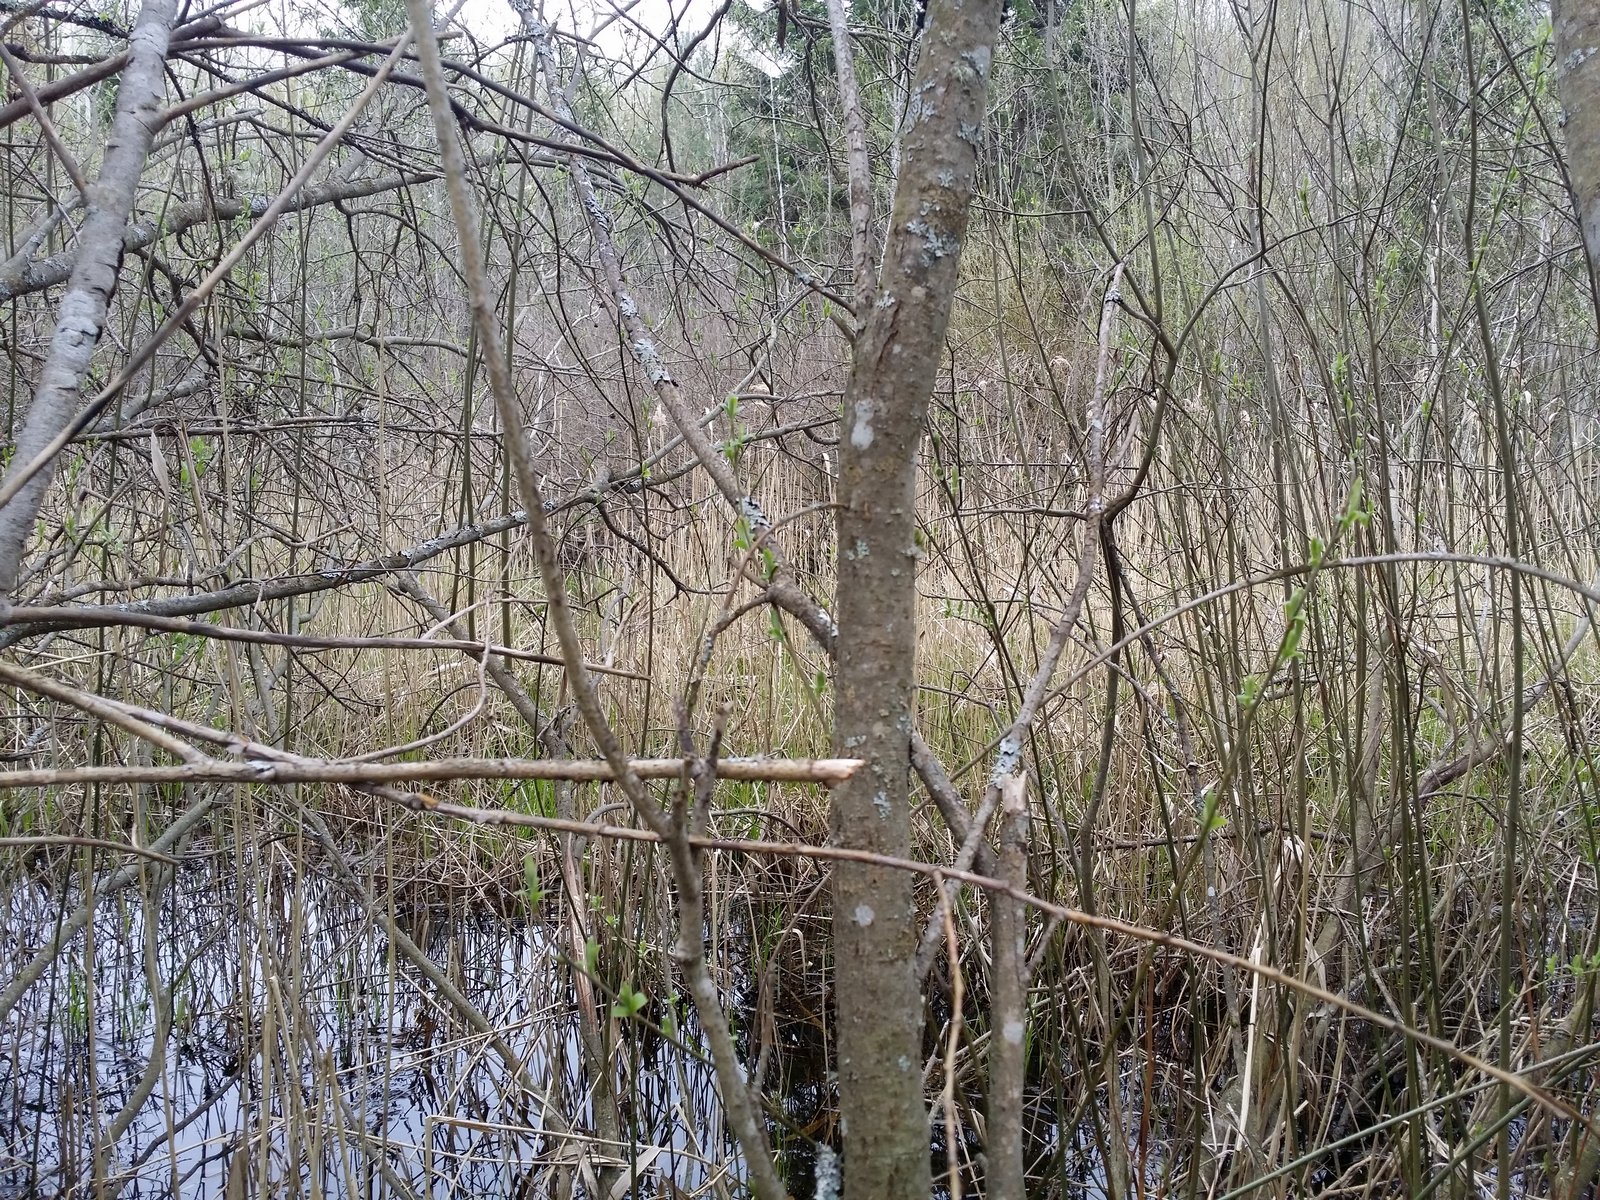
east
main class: Woodland
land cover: Broadleaved woodland
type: mire and swamp forests
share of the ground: > 75 %
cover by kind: broadleaved forest trees 70 %, coniferous forest trees 20 %, lichens and mosses 10 %
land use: Semi-natural and natural areas not in use
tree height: < 5 m
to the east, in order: Broadleaved woodland; Spruce dominated mixed woodland; Broadleaved woodland
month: May
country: LV
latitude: 57.4697
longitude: 26.0188
